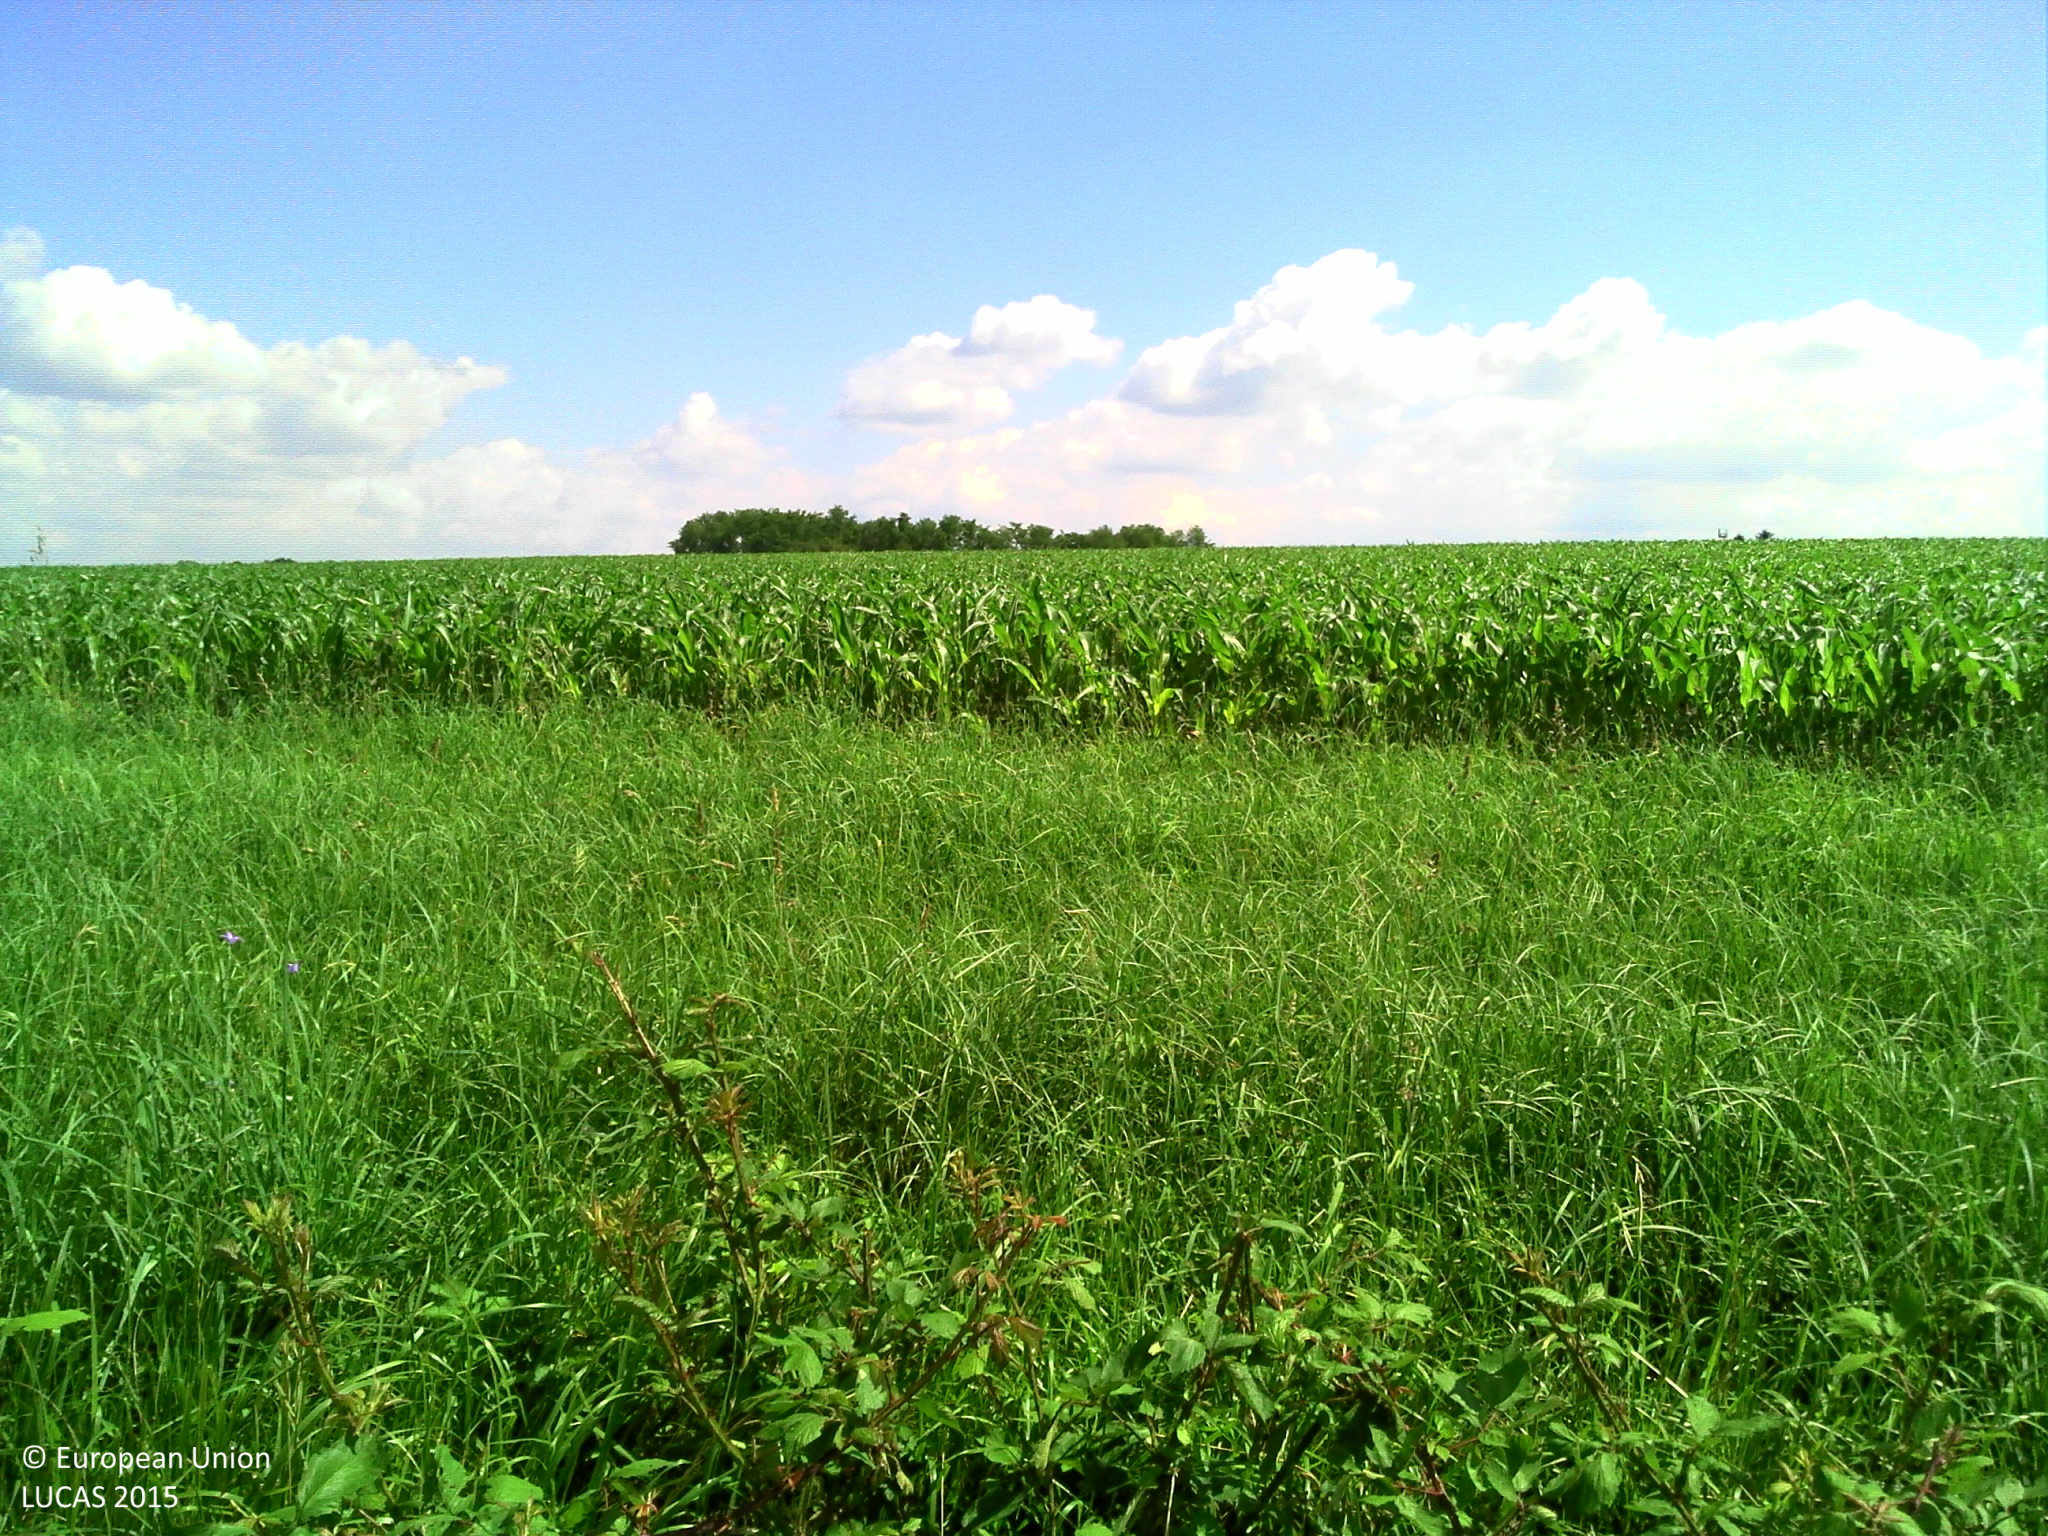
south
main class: Grassland
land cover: Grassland without tree/shrub cover
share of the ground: > 75 %
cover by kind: herbaceous plants 95 %, shrubs 5 %
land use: Agriculture (excluding fallow land and kitchen gardens)
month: June
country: FR
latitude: 43.2682
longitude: -0.1694
